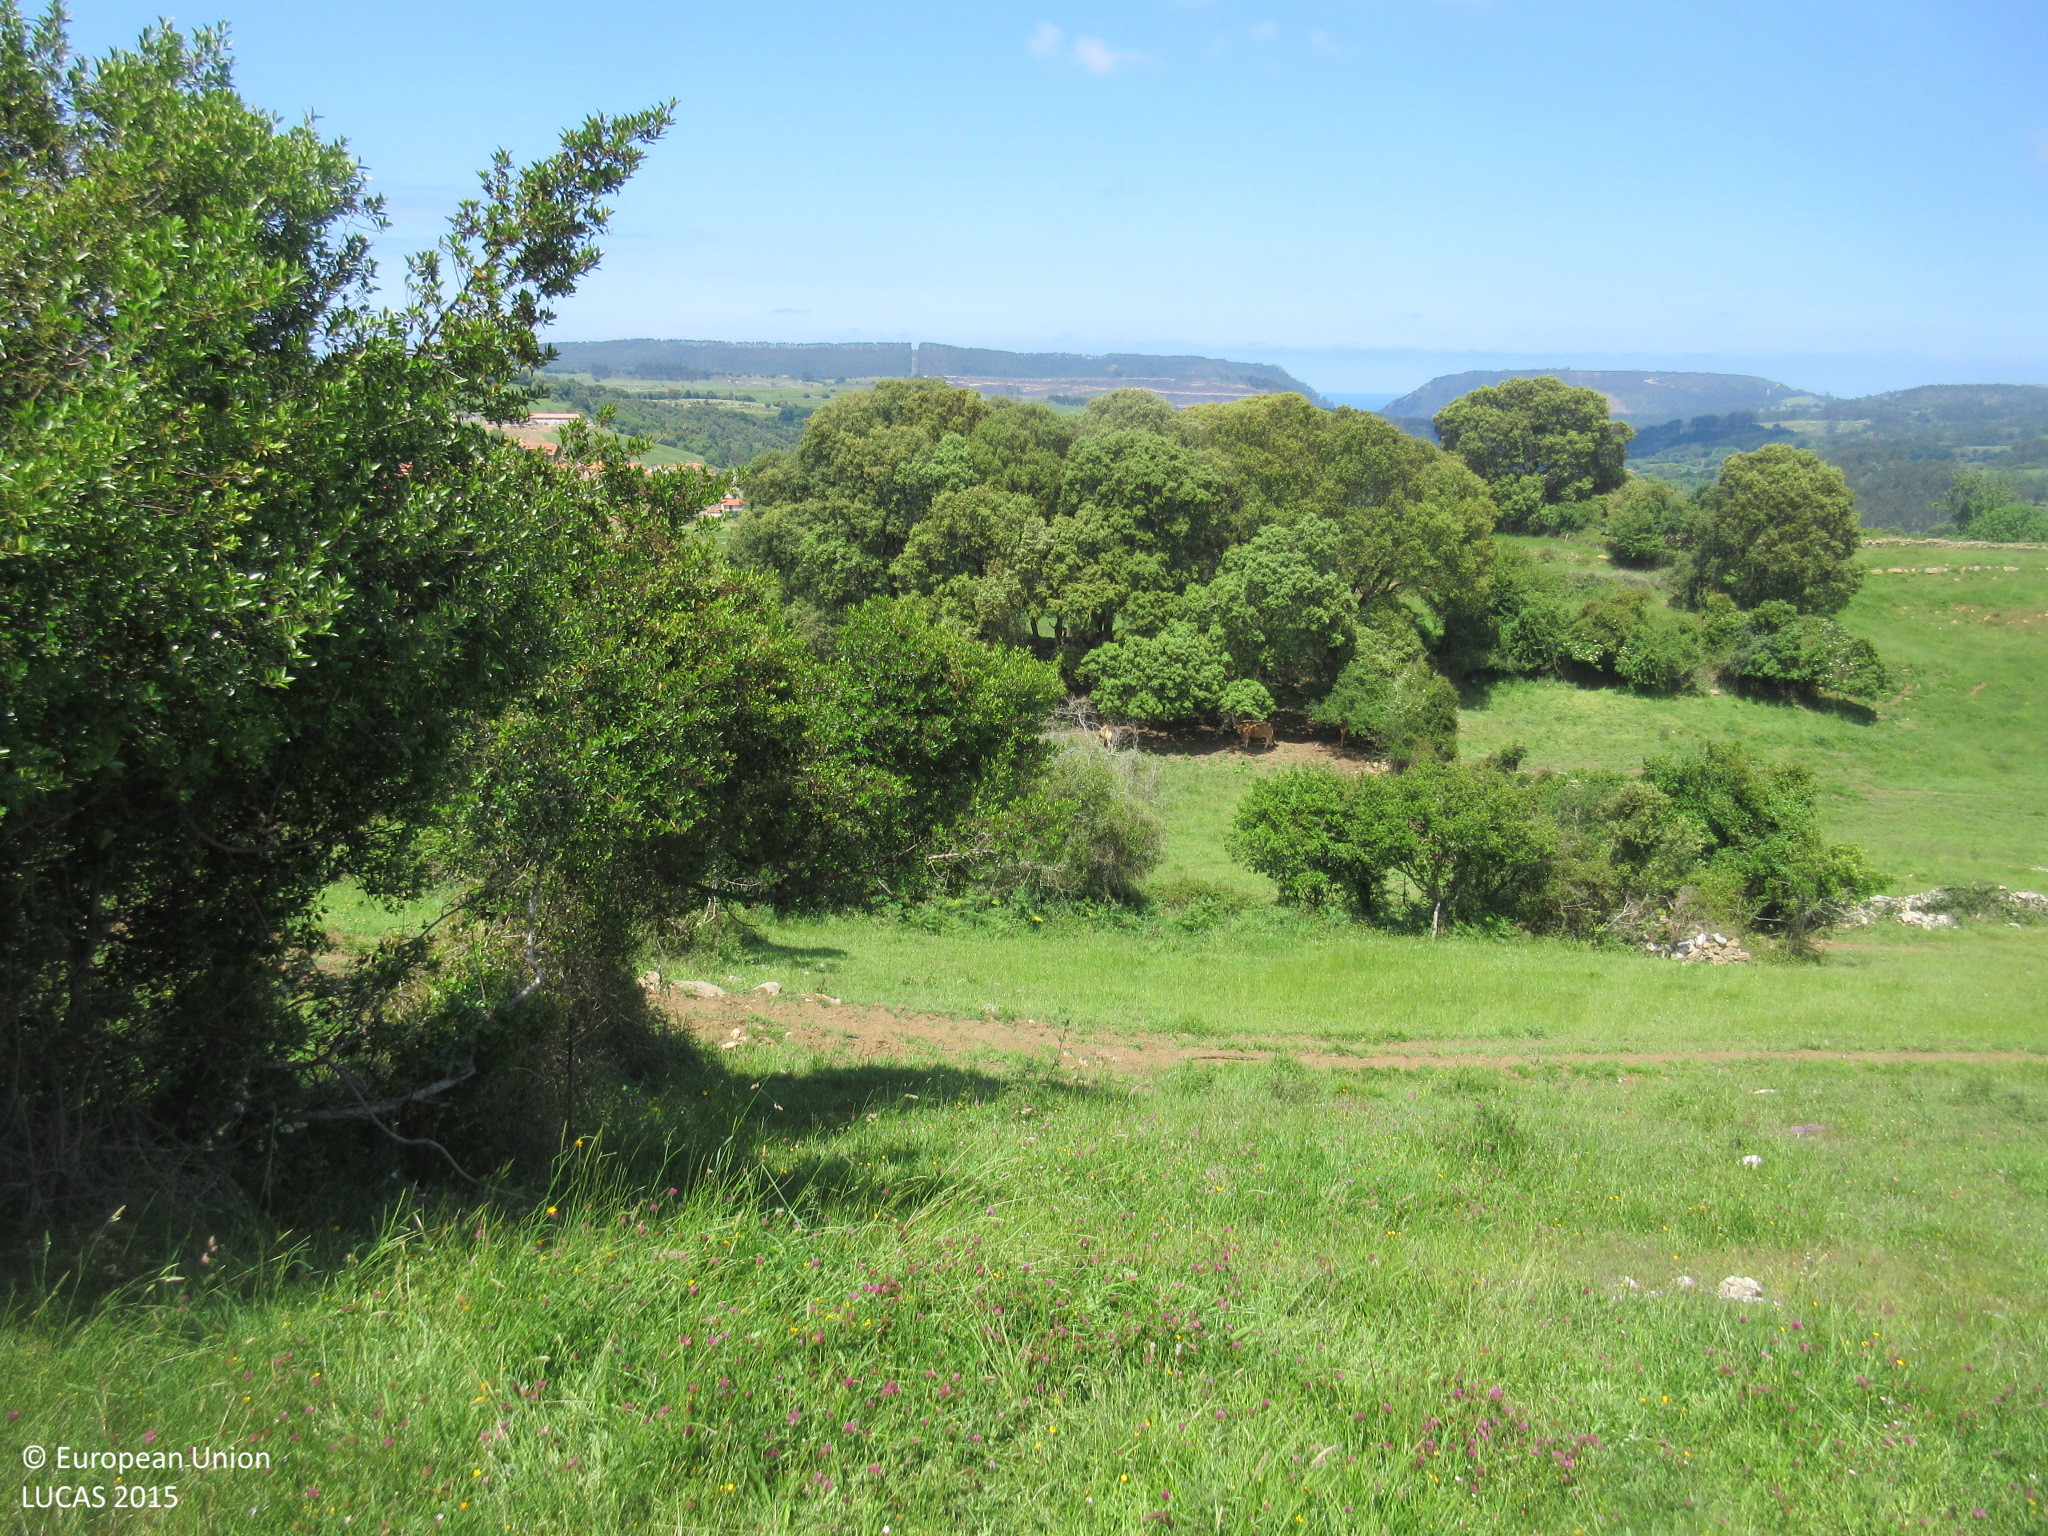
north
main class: Shrubland
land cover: Shrubland with sparse tree cover
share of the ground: > 75 %
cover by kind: shrubs 95 %, broadleaved forest trees 5 %
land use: Agriculture (excluding fallow land and kitchen gardens)
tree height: < 5 m
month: May
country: ES
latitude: 43.3433
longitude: -4.5052
